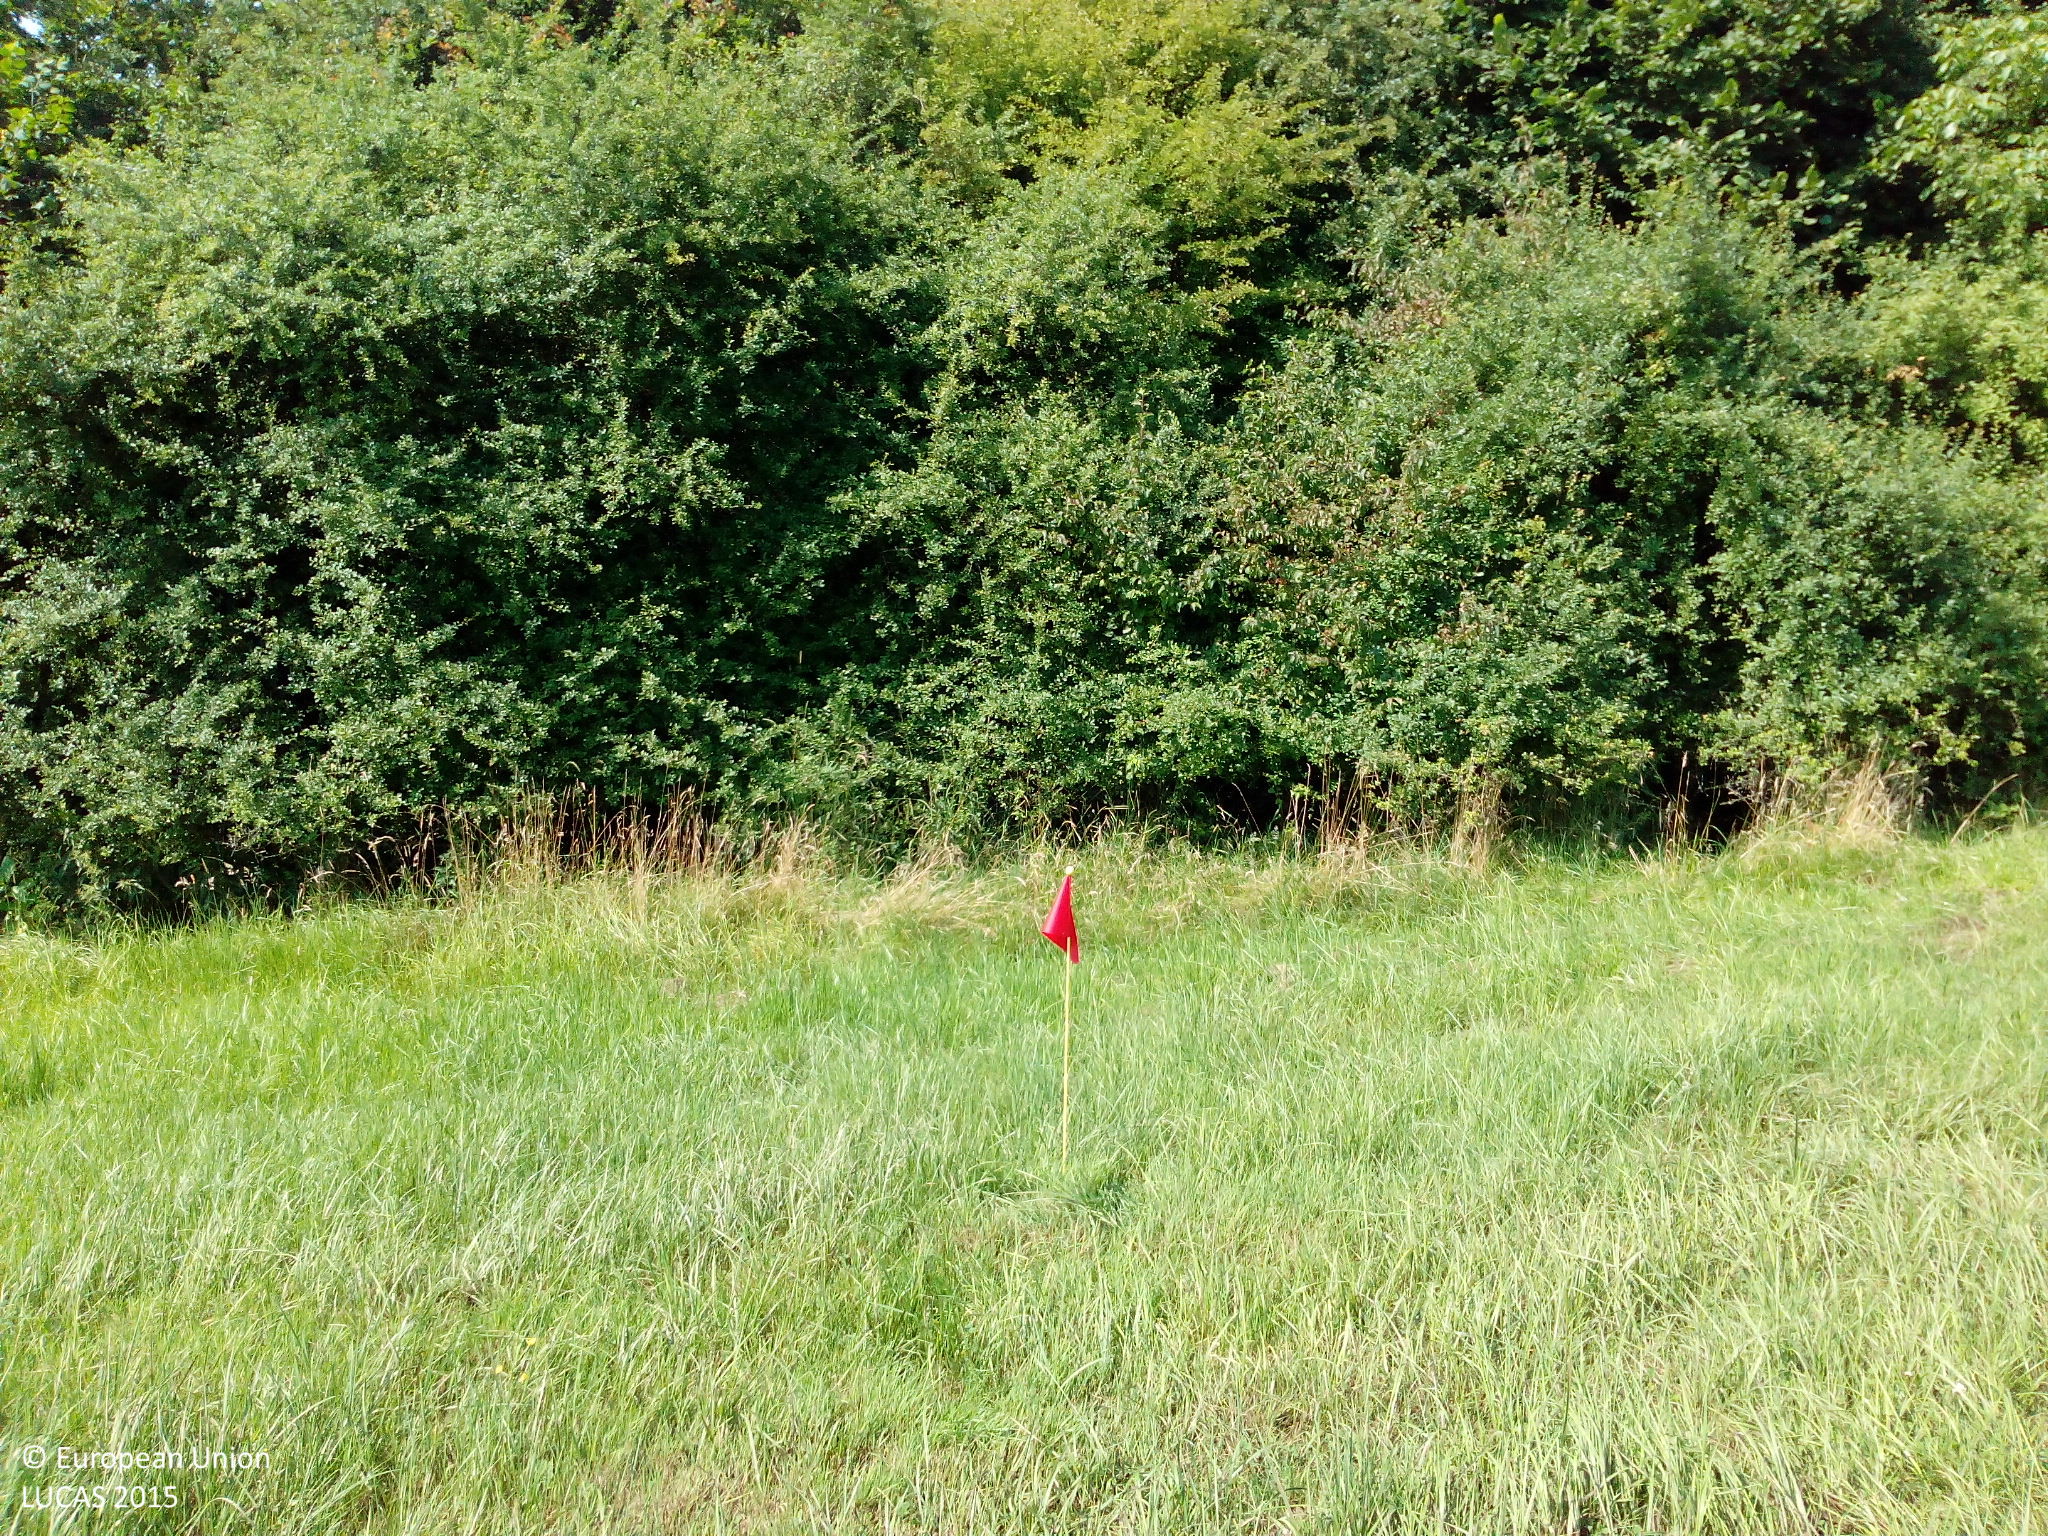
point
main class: Grassland
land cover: Grassland without tree/shrub cover
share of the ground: > 75 %
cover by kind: herbaceous plants 100 %
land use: Agriculture (excluding fallow land and kitchen gardens)
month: July
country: DE
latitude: 48.2756
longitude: 12.8960
